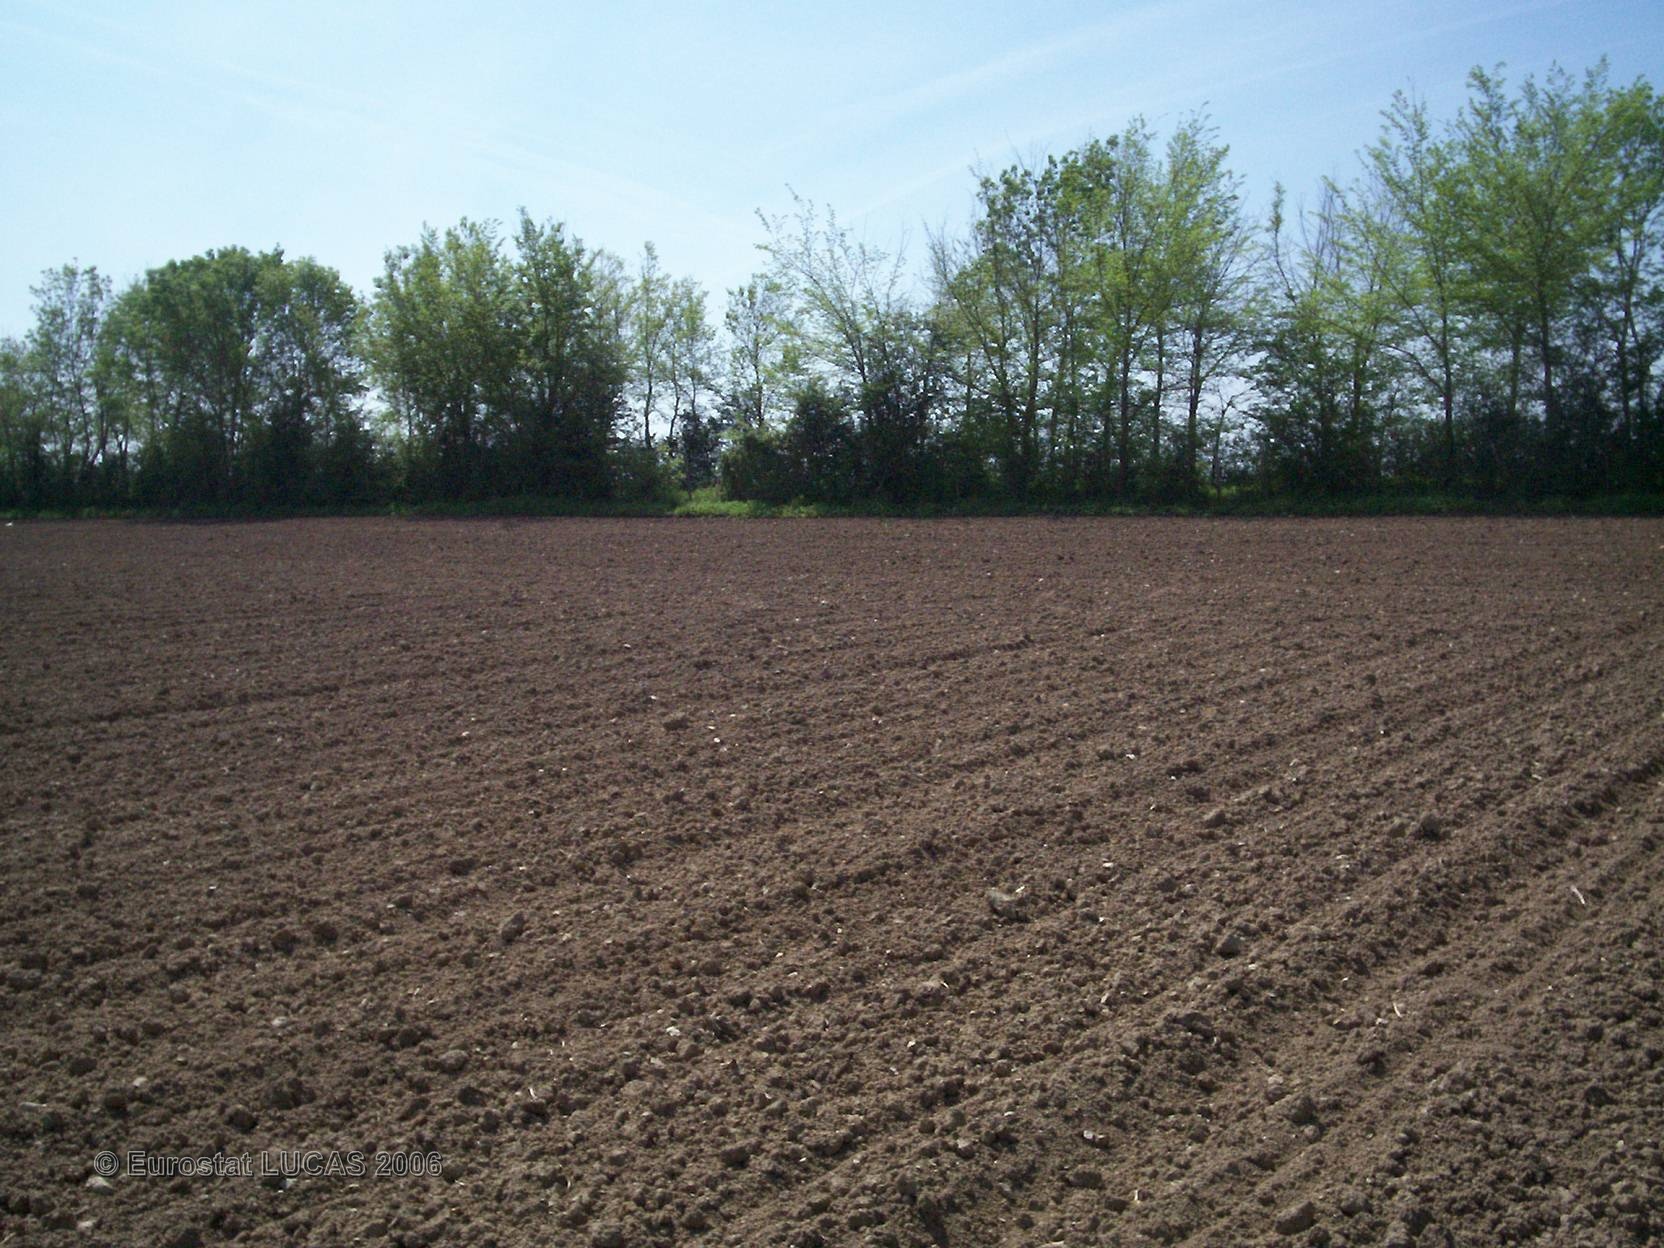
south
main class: Cropland
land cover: Maize
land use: Agriculture (excluding fallow land and kitchen gardens)
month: May
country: FR
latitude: 46.1491
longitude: -0.2377
